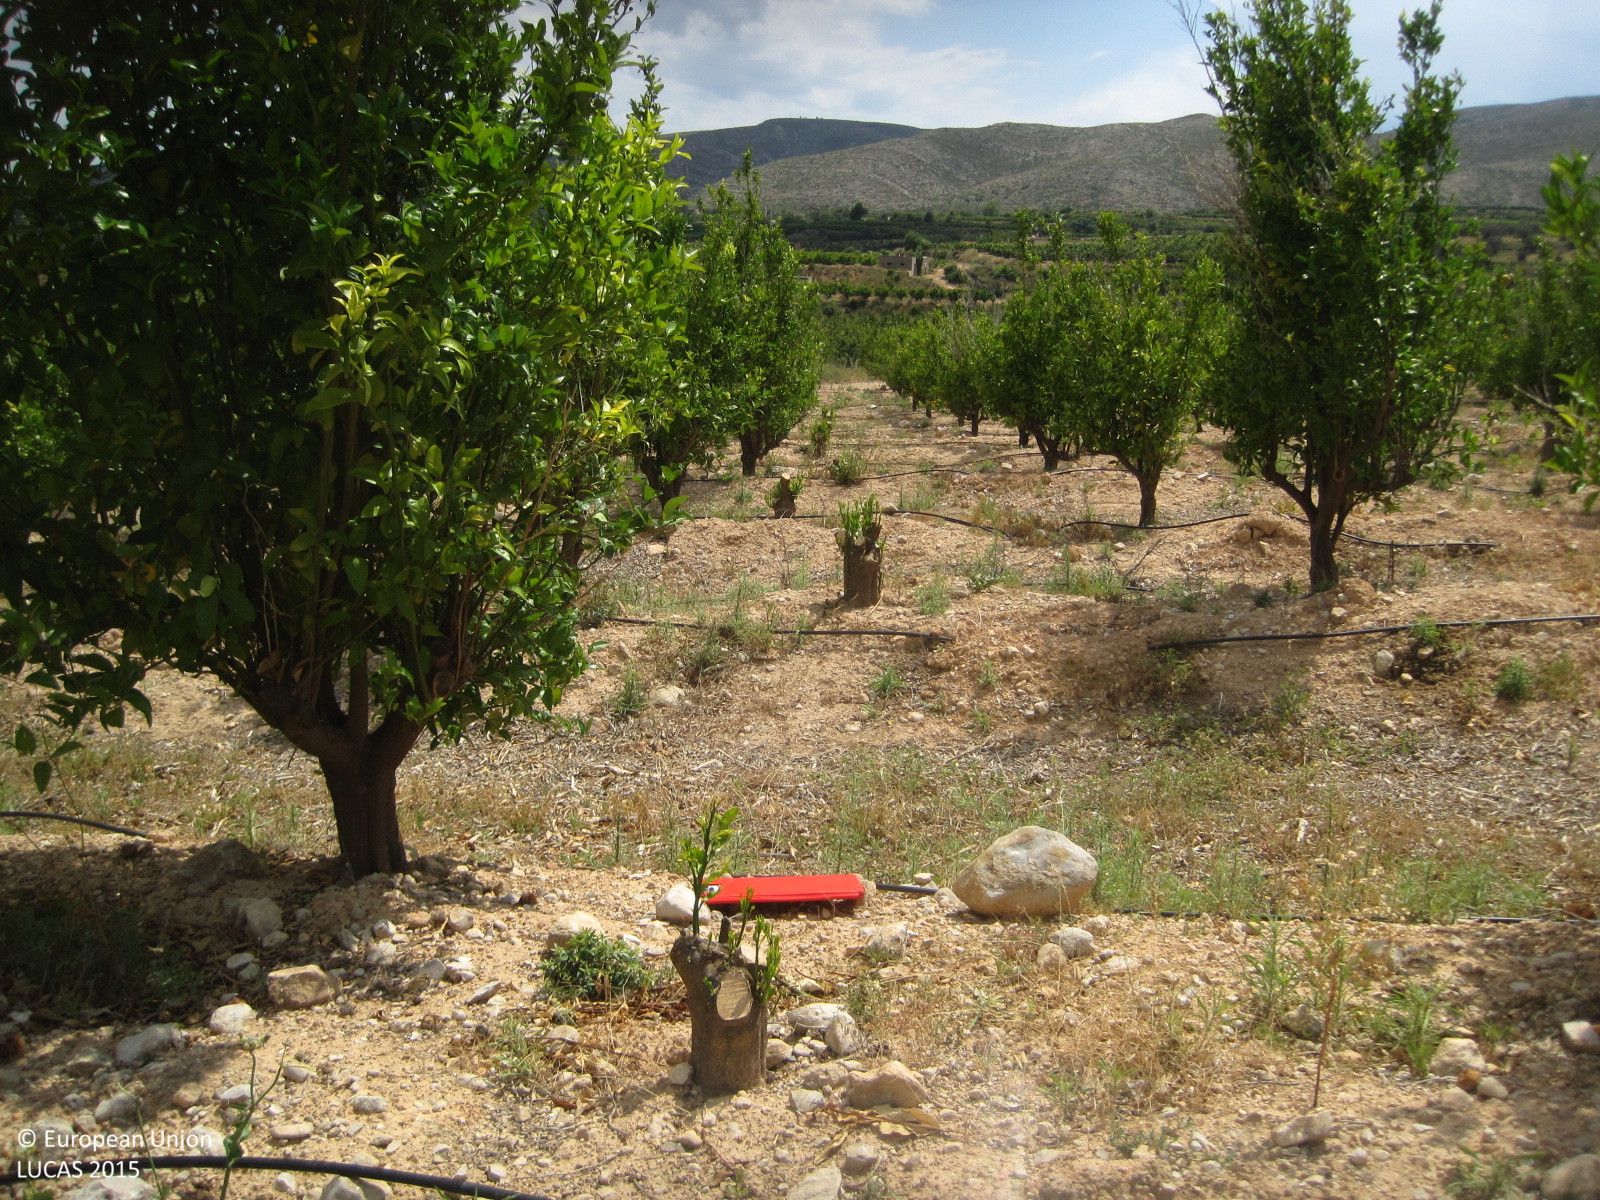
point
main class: Cropland
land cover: Other citrus fruit
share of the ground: 10 - 25 %
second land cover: Spontaneously vegetated surfaces
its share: 50 - 75 %
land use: Agriculture (excluding fallow land and kitchen gardens)
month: June
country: ES
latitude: 39.2666
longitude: -0.6478
